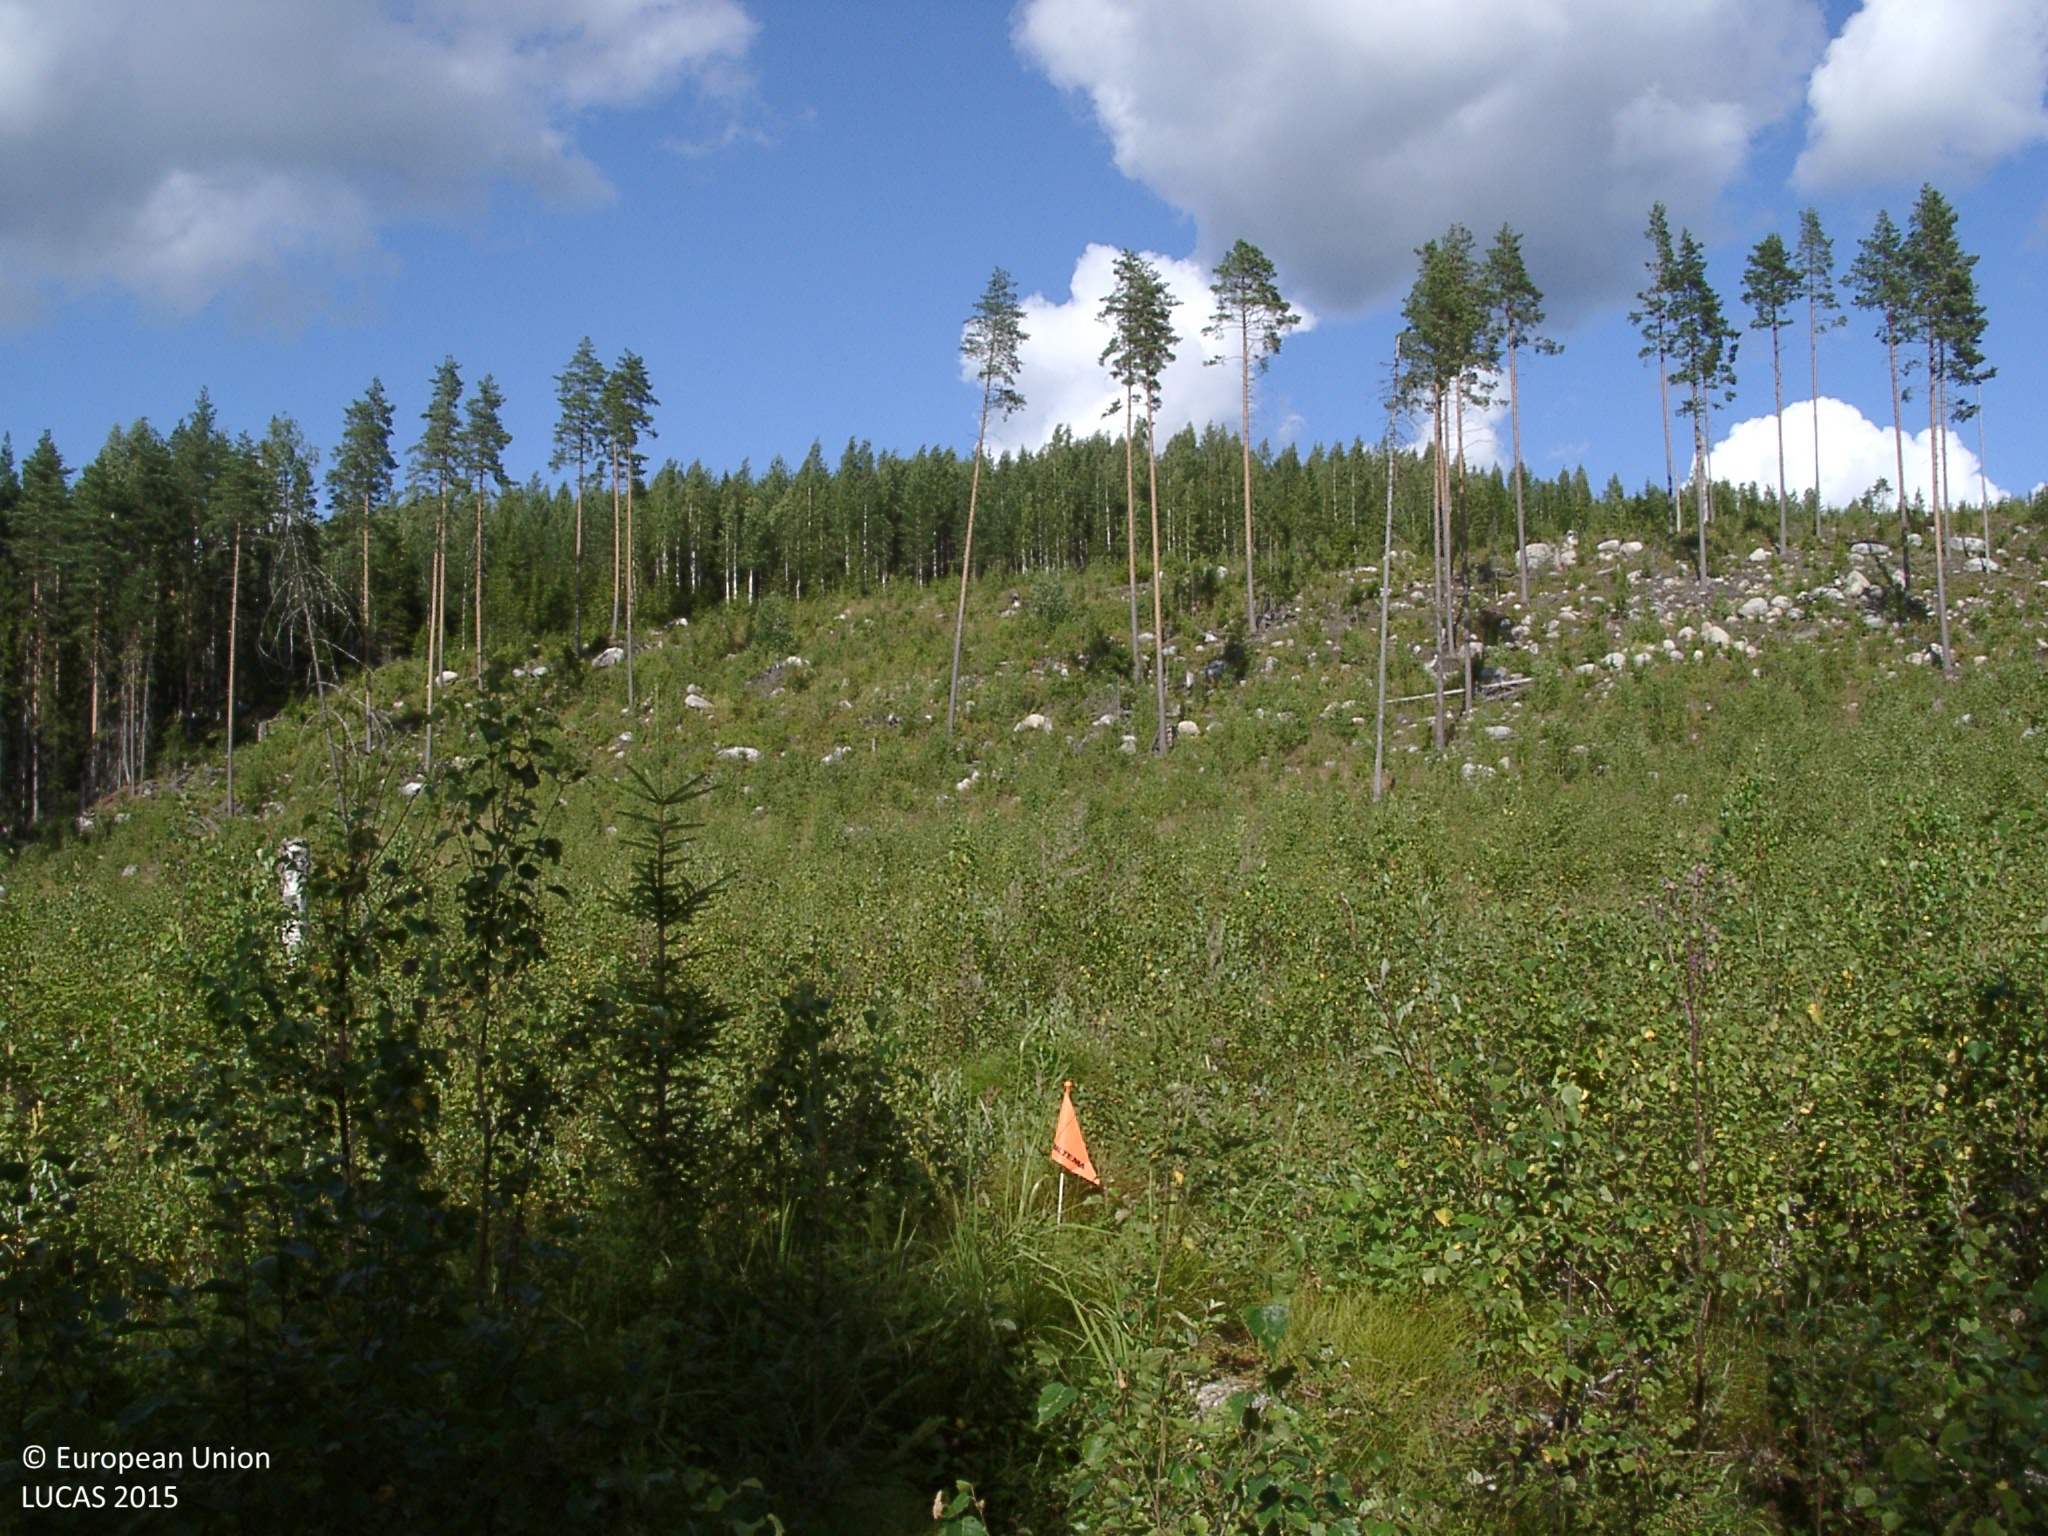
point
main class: Woodland
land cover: Broadleaved woodland
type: boreal forest
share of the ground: 50 - 75 %
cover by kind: broadleaved forest trees 50 %, herbaceous plants 30 %, shrubs 10 %, coniferous forest trees 5 %, lichens and mosses 5 %
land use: Forestry
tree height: < 5 m
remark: Nursery
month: August
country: FI
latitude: 62.4007
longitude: 25.7722
